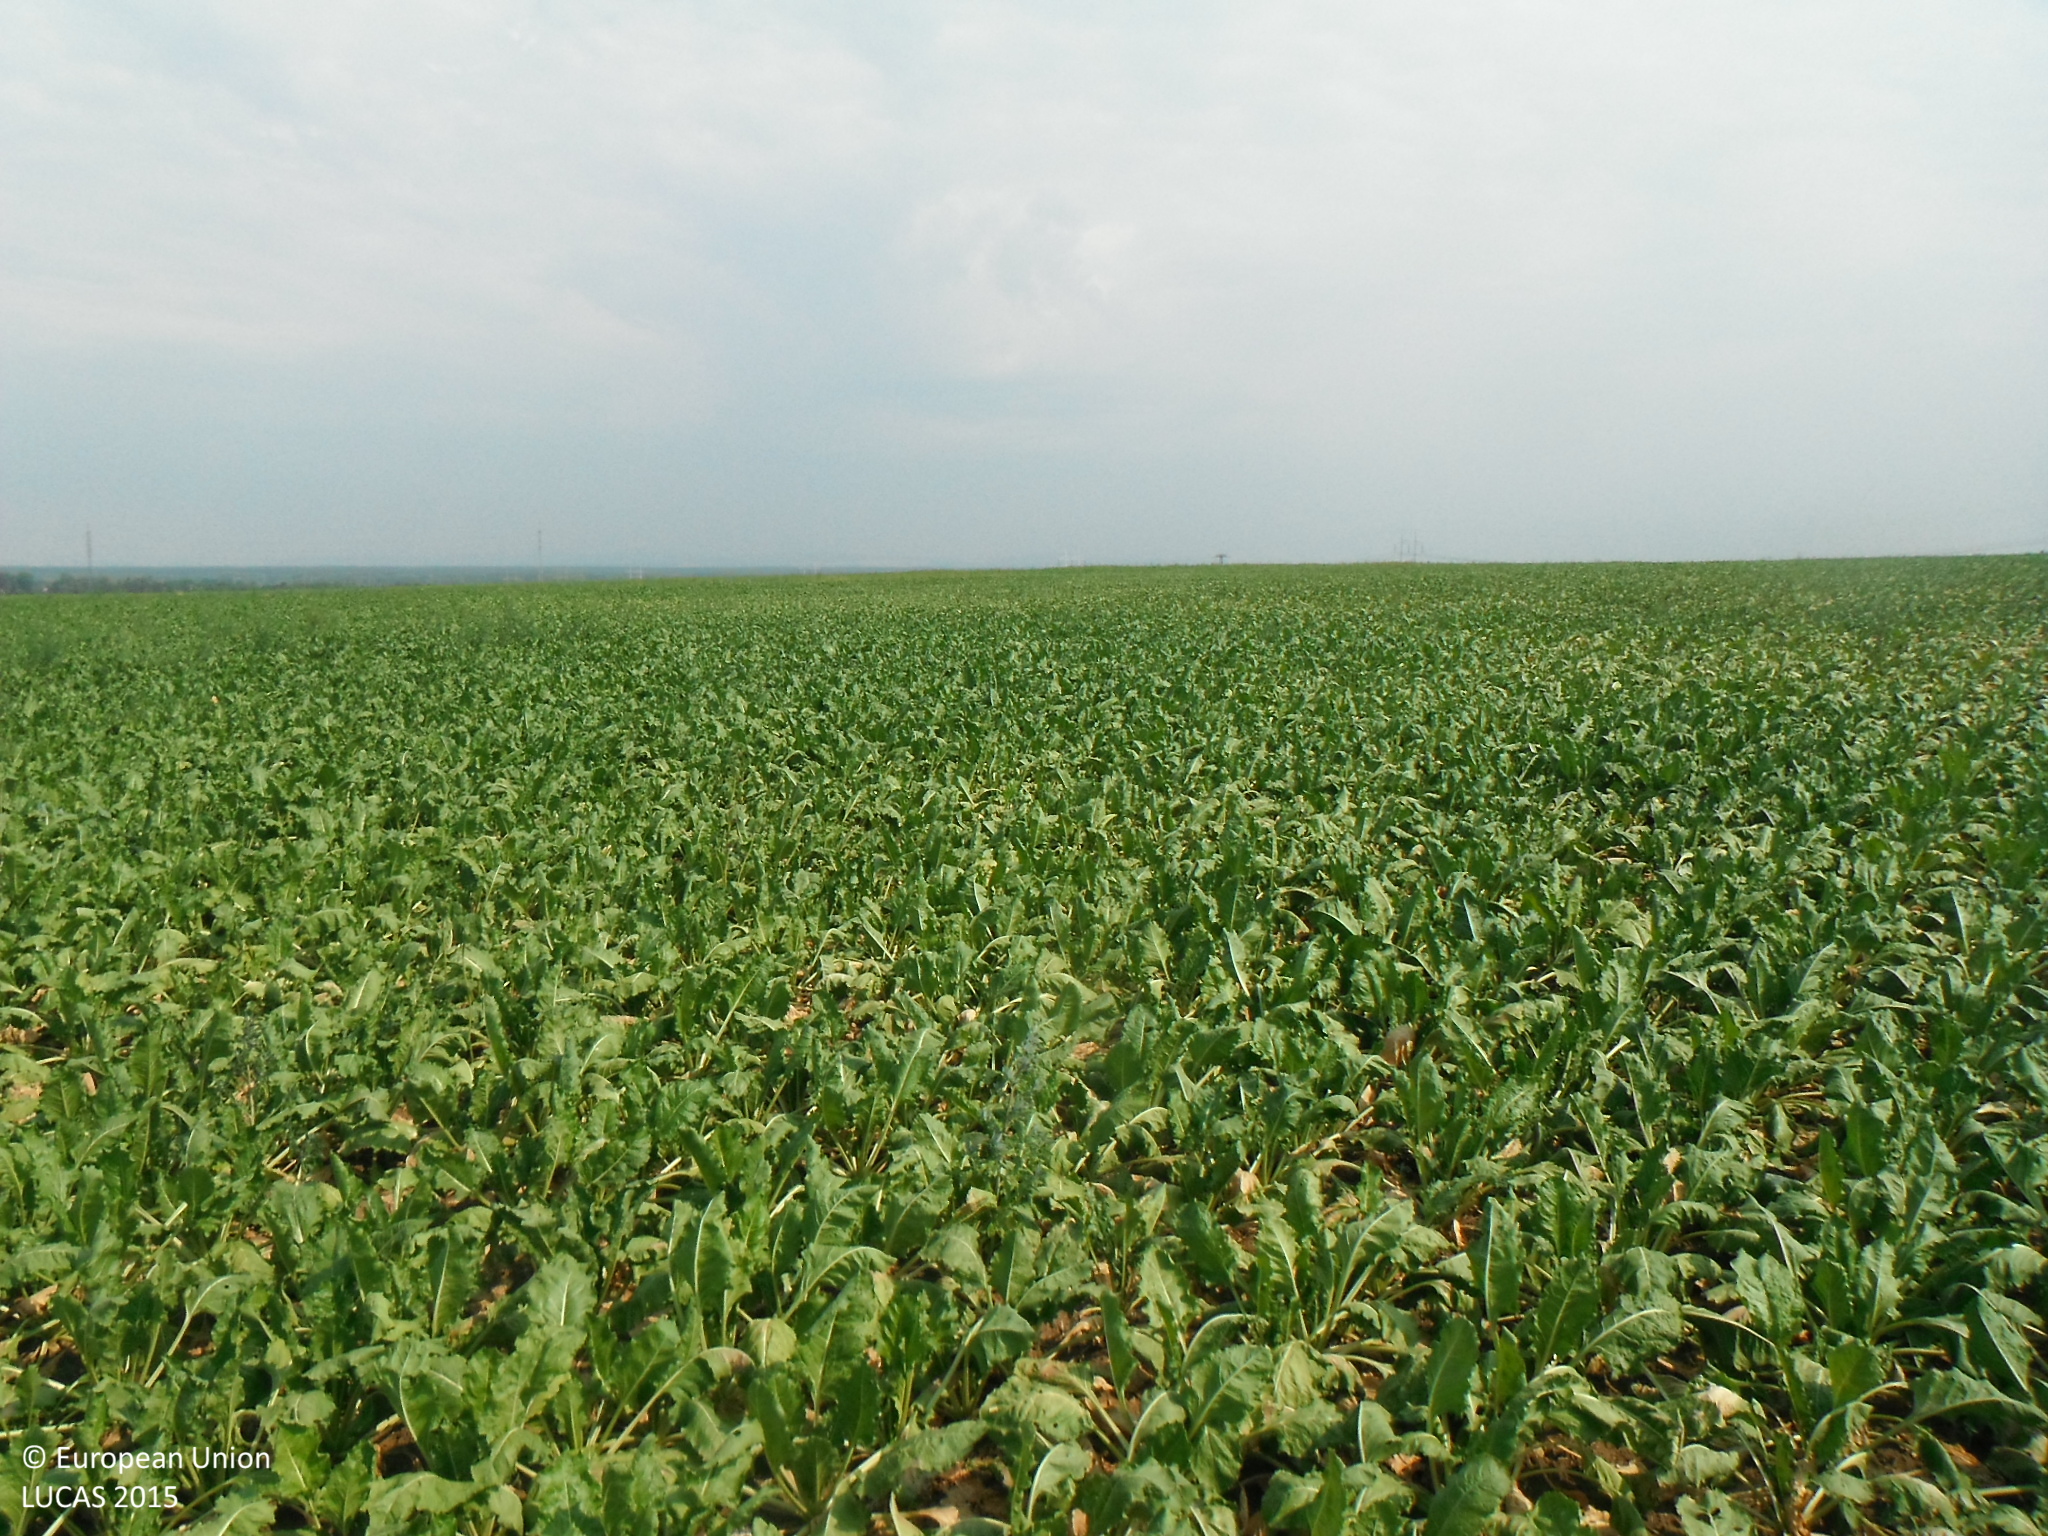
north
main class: Cropland
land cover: Sugar beet
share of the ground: > 75 %
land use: Agriculture (excluding fallow land and kitchen gardens)
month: July
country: SK
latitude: 48.8520
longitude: 17.2466
